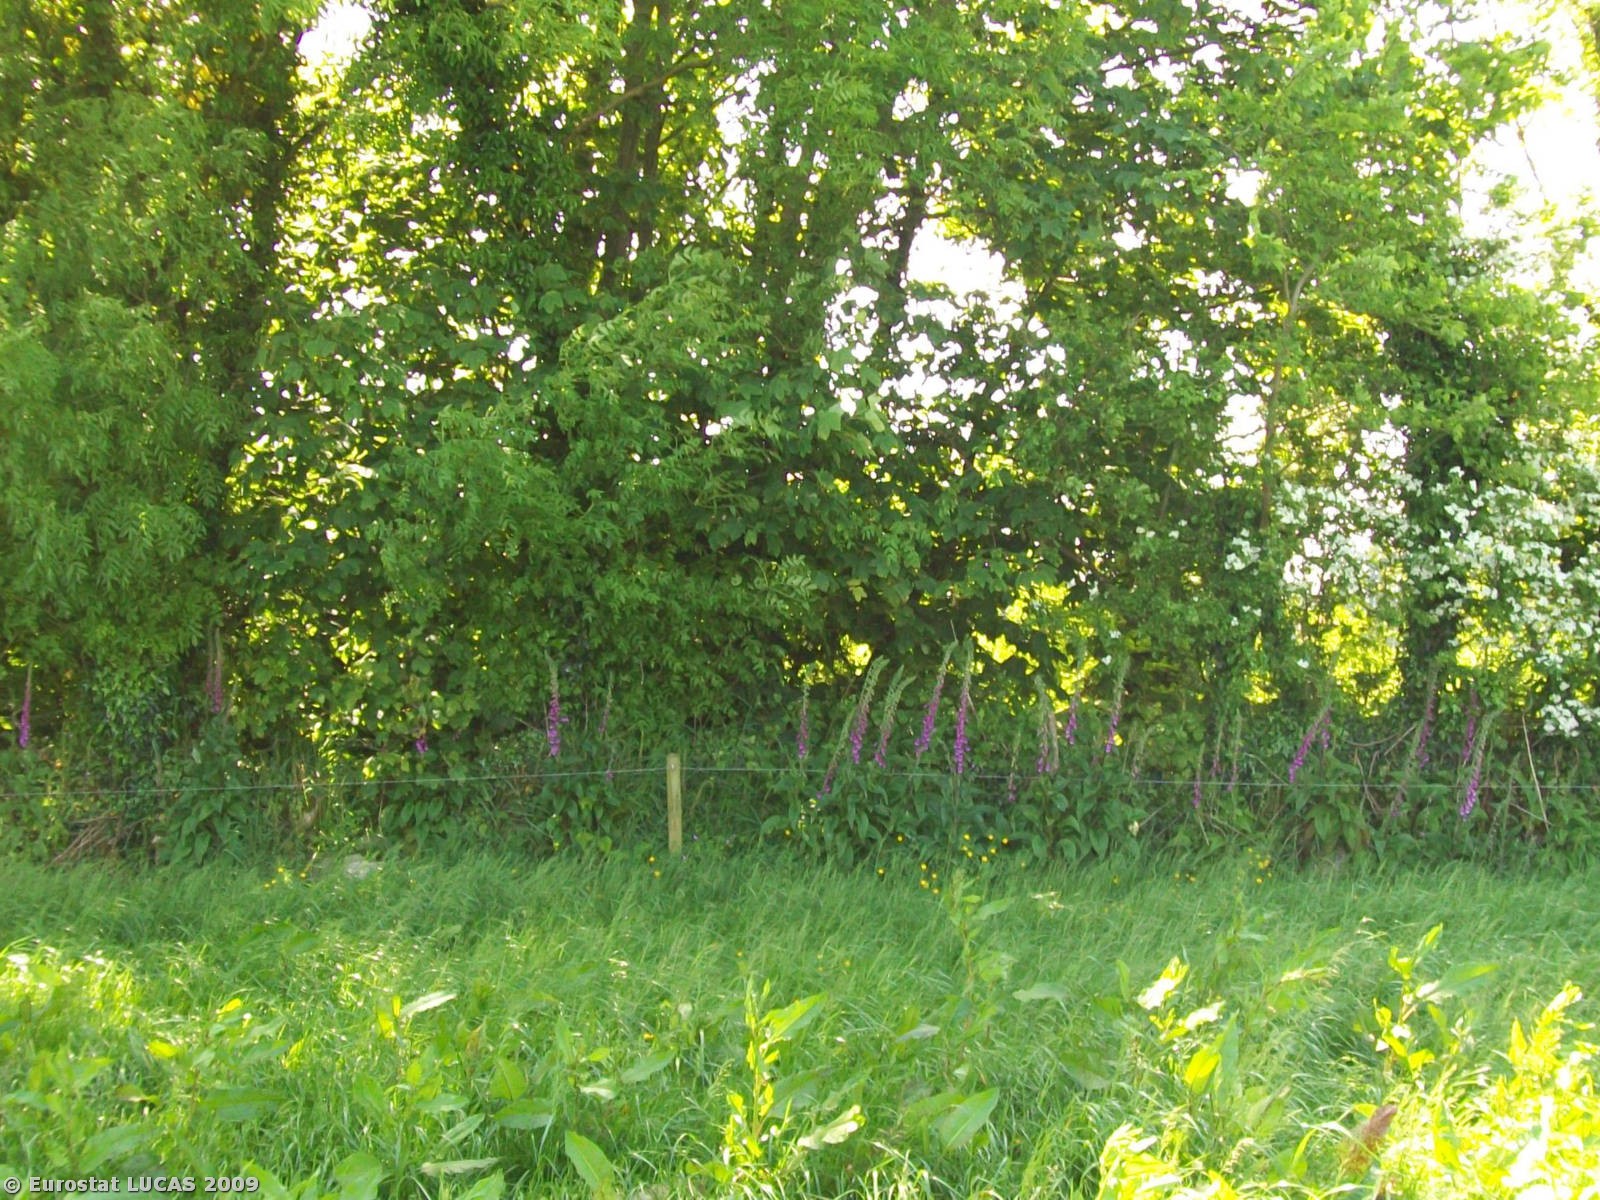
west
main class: Grassland
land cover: Grassland without tree/shrub cover
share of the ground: > 75 %
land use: Agriculture (excluding fallow land and kitchen gardens)
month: July
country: IE
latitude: 52.5262
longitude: -7.6907
